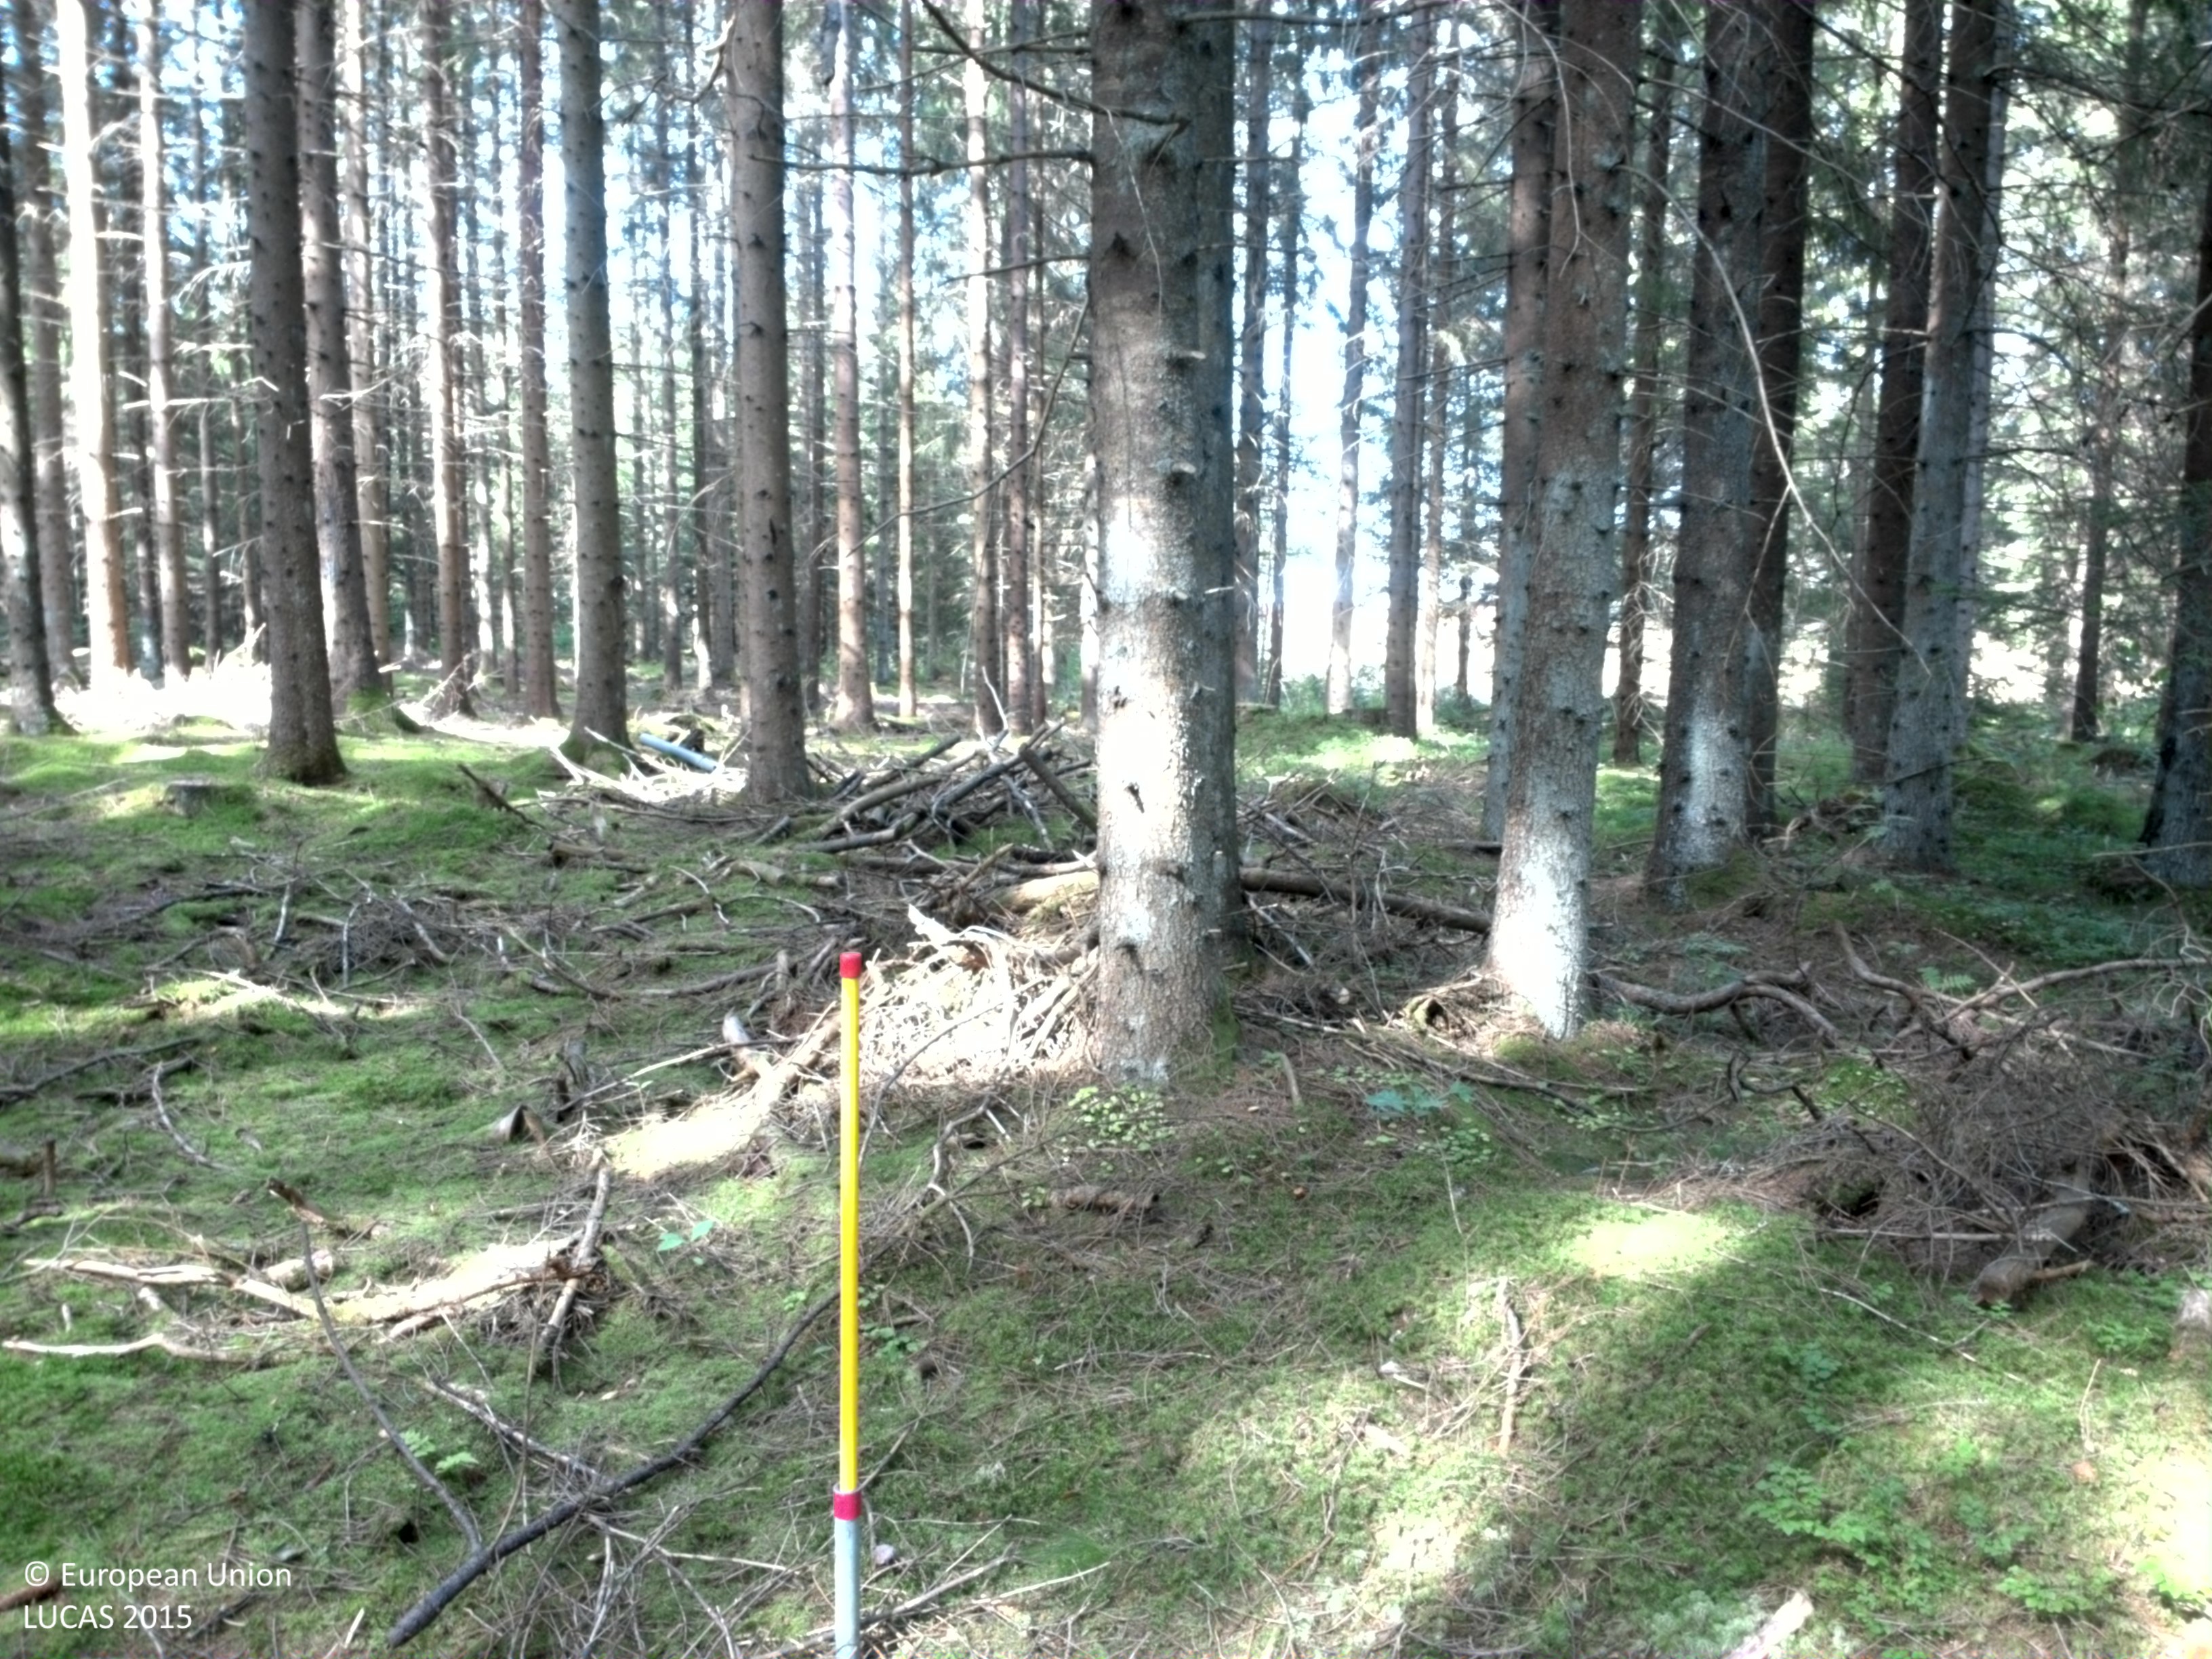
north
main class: Woodland
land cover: Spruce dominated coniferous woodland
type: boreal forest
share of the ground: 50 - 75 %
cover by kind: coniferous forest trees 55 %, lichens and mosses 35 %, shrubs 5 %, herbaceous plants 5 %
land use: Forestry
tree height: > 5 m
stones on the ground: < 10 %
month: August
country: SE
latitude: 58.7888
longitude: 14.0588
